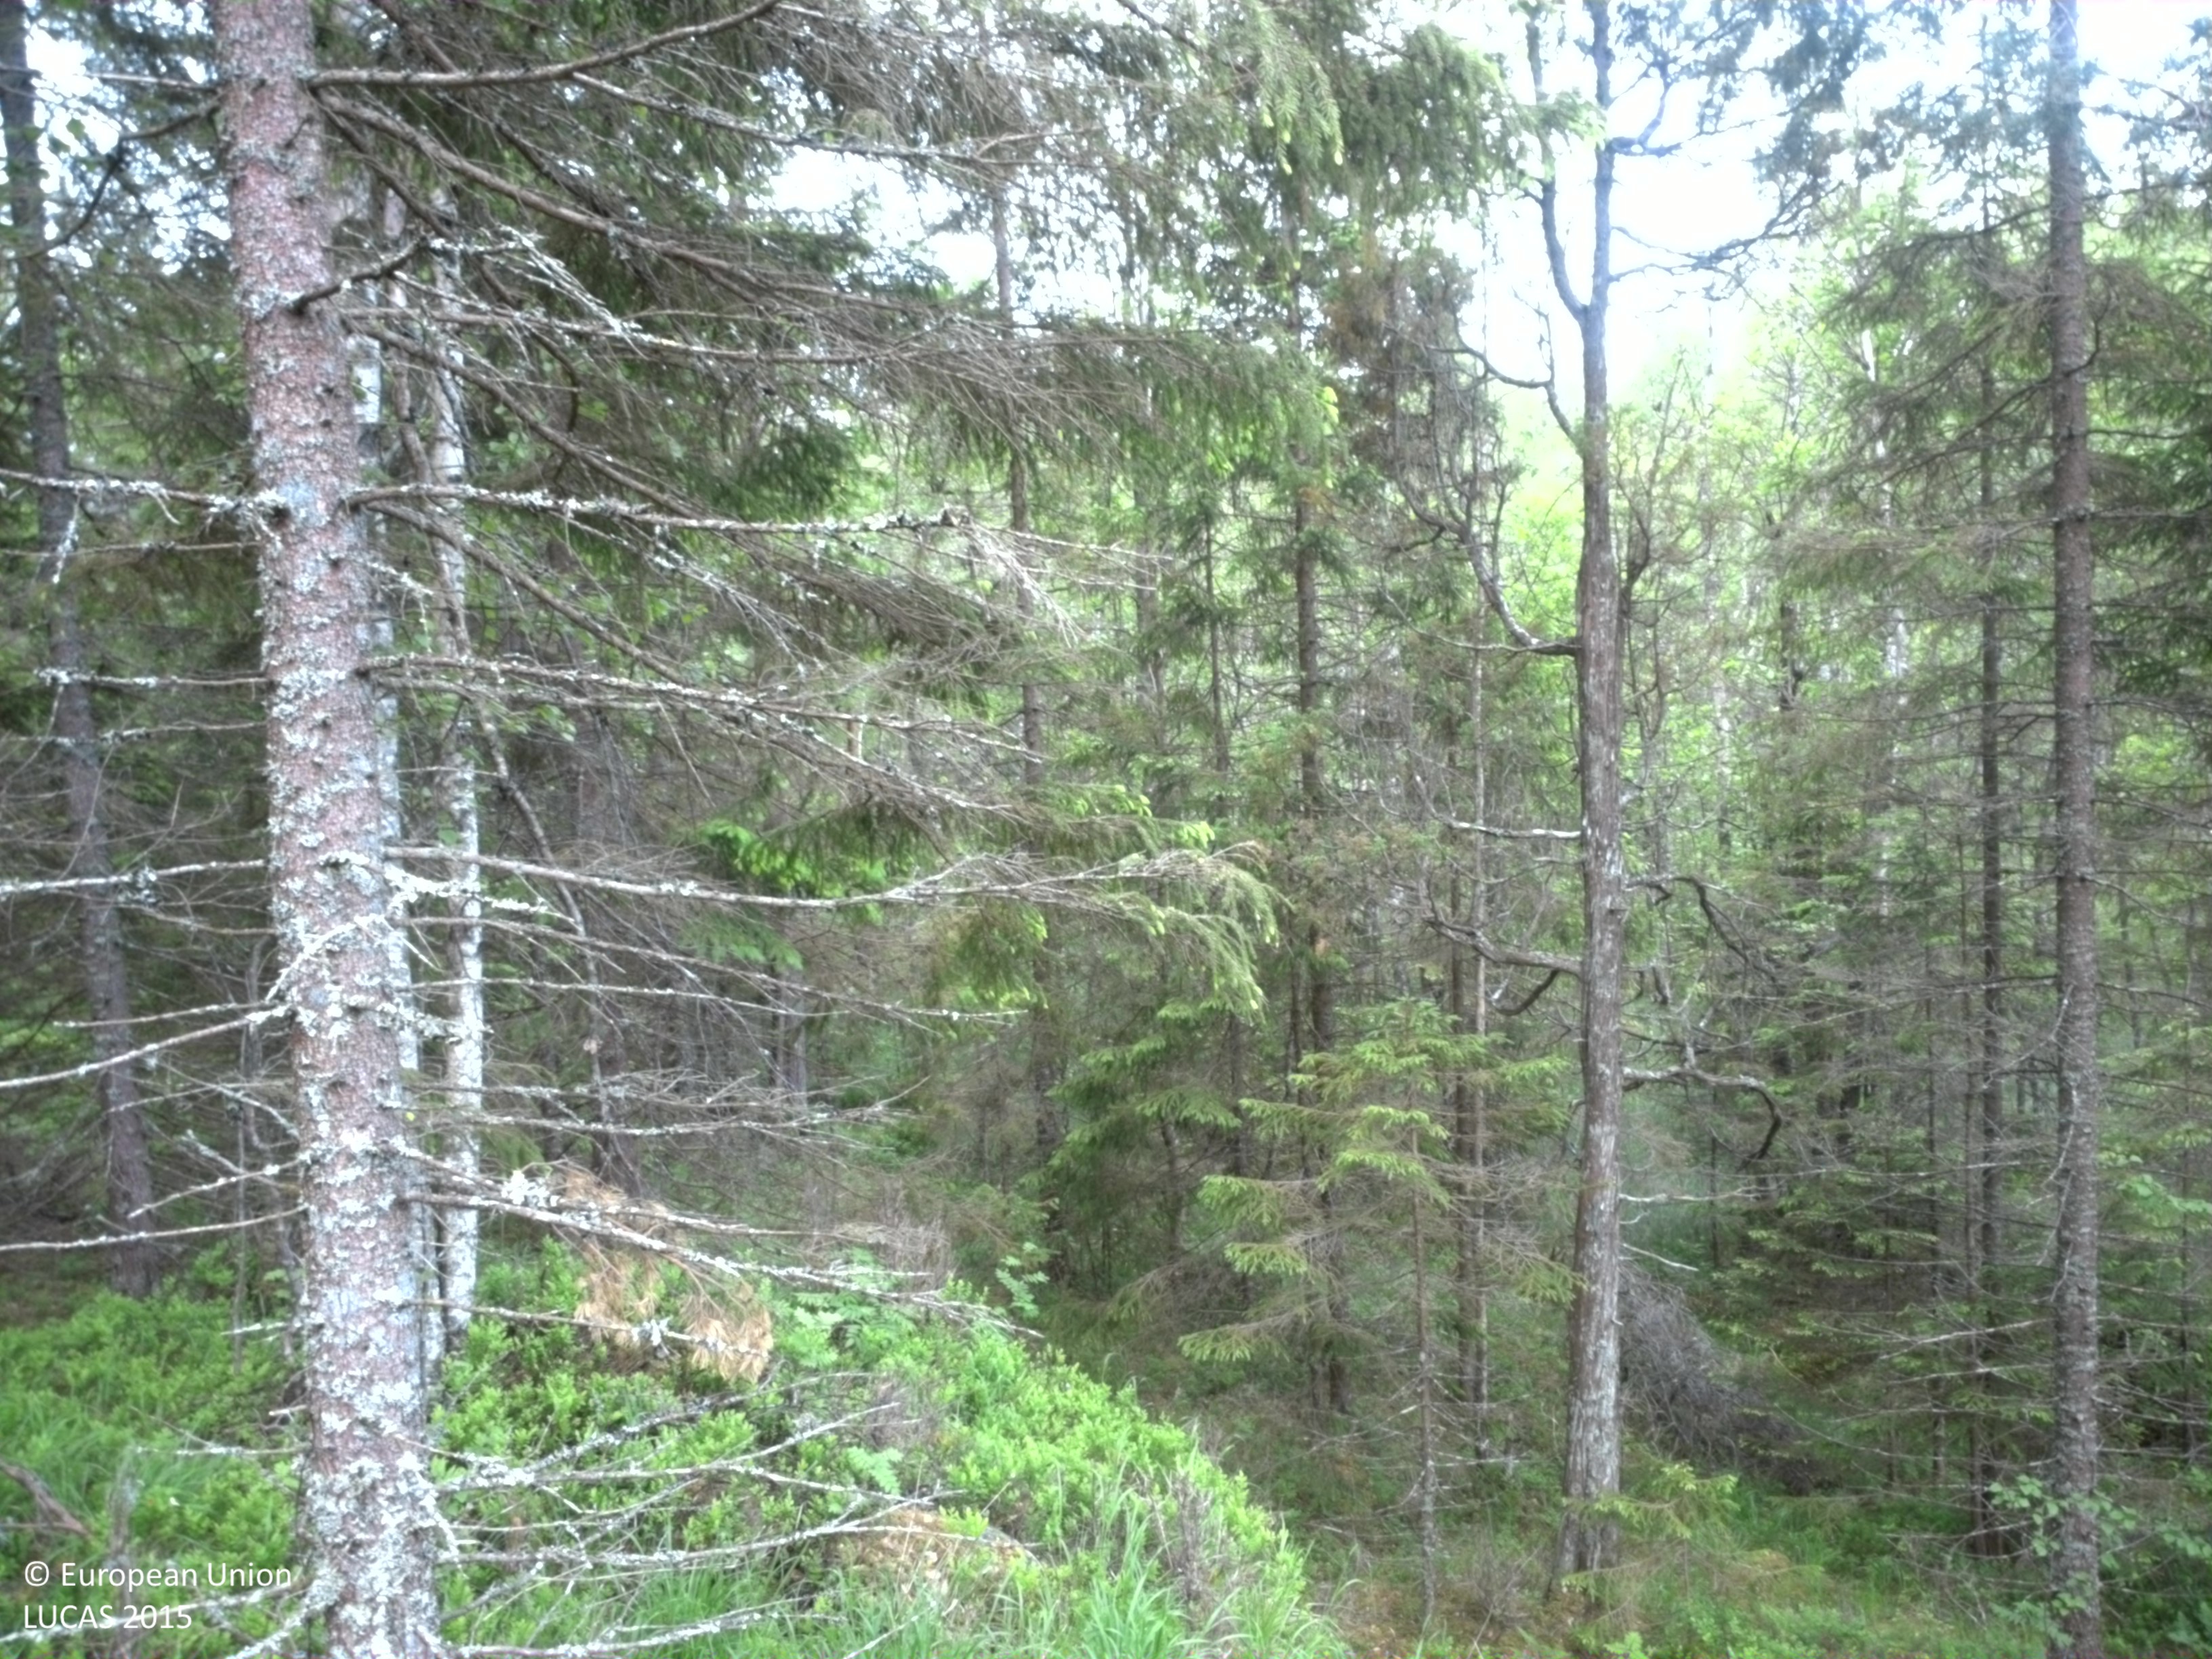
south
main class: Shrubland
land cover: Shrubland with sparse tree cover
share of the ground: 50 - 75 %
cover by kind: shrubs 70 %, lichens and mosses 10 %, consolidated bare surface 10 %, coniferous forest trees 5 %, herbaceous plants 5 %
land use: Forestry
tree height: < 5 m
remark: Clear cut
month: June
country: SE
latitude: 59.7512
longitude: 12.0764
